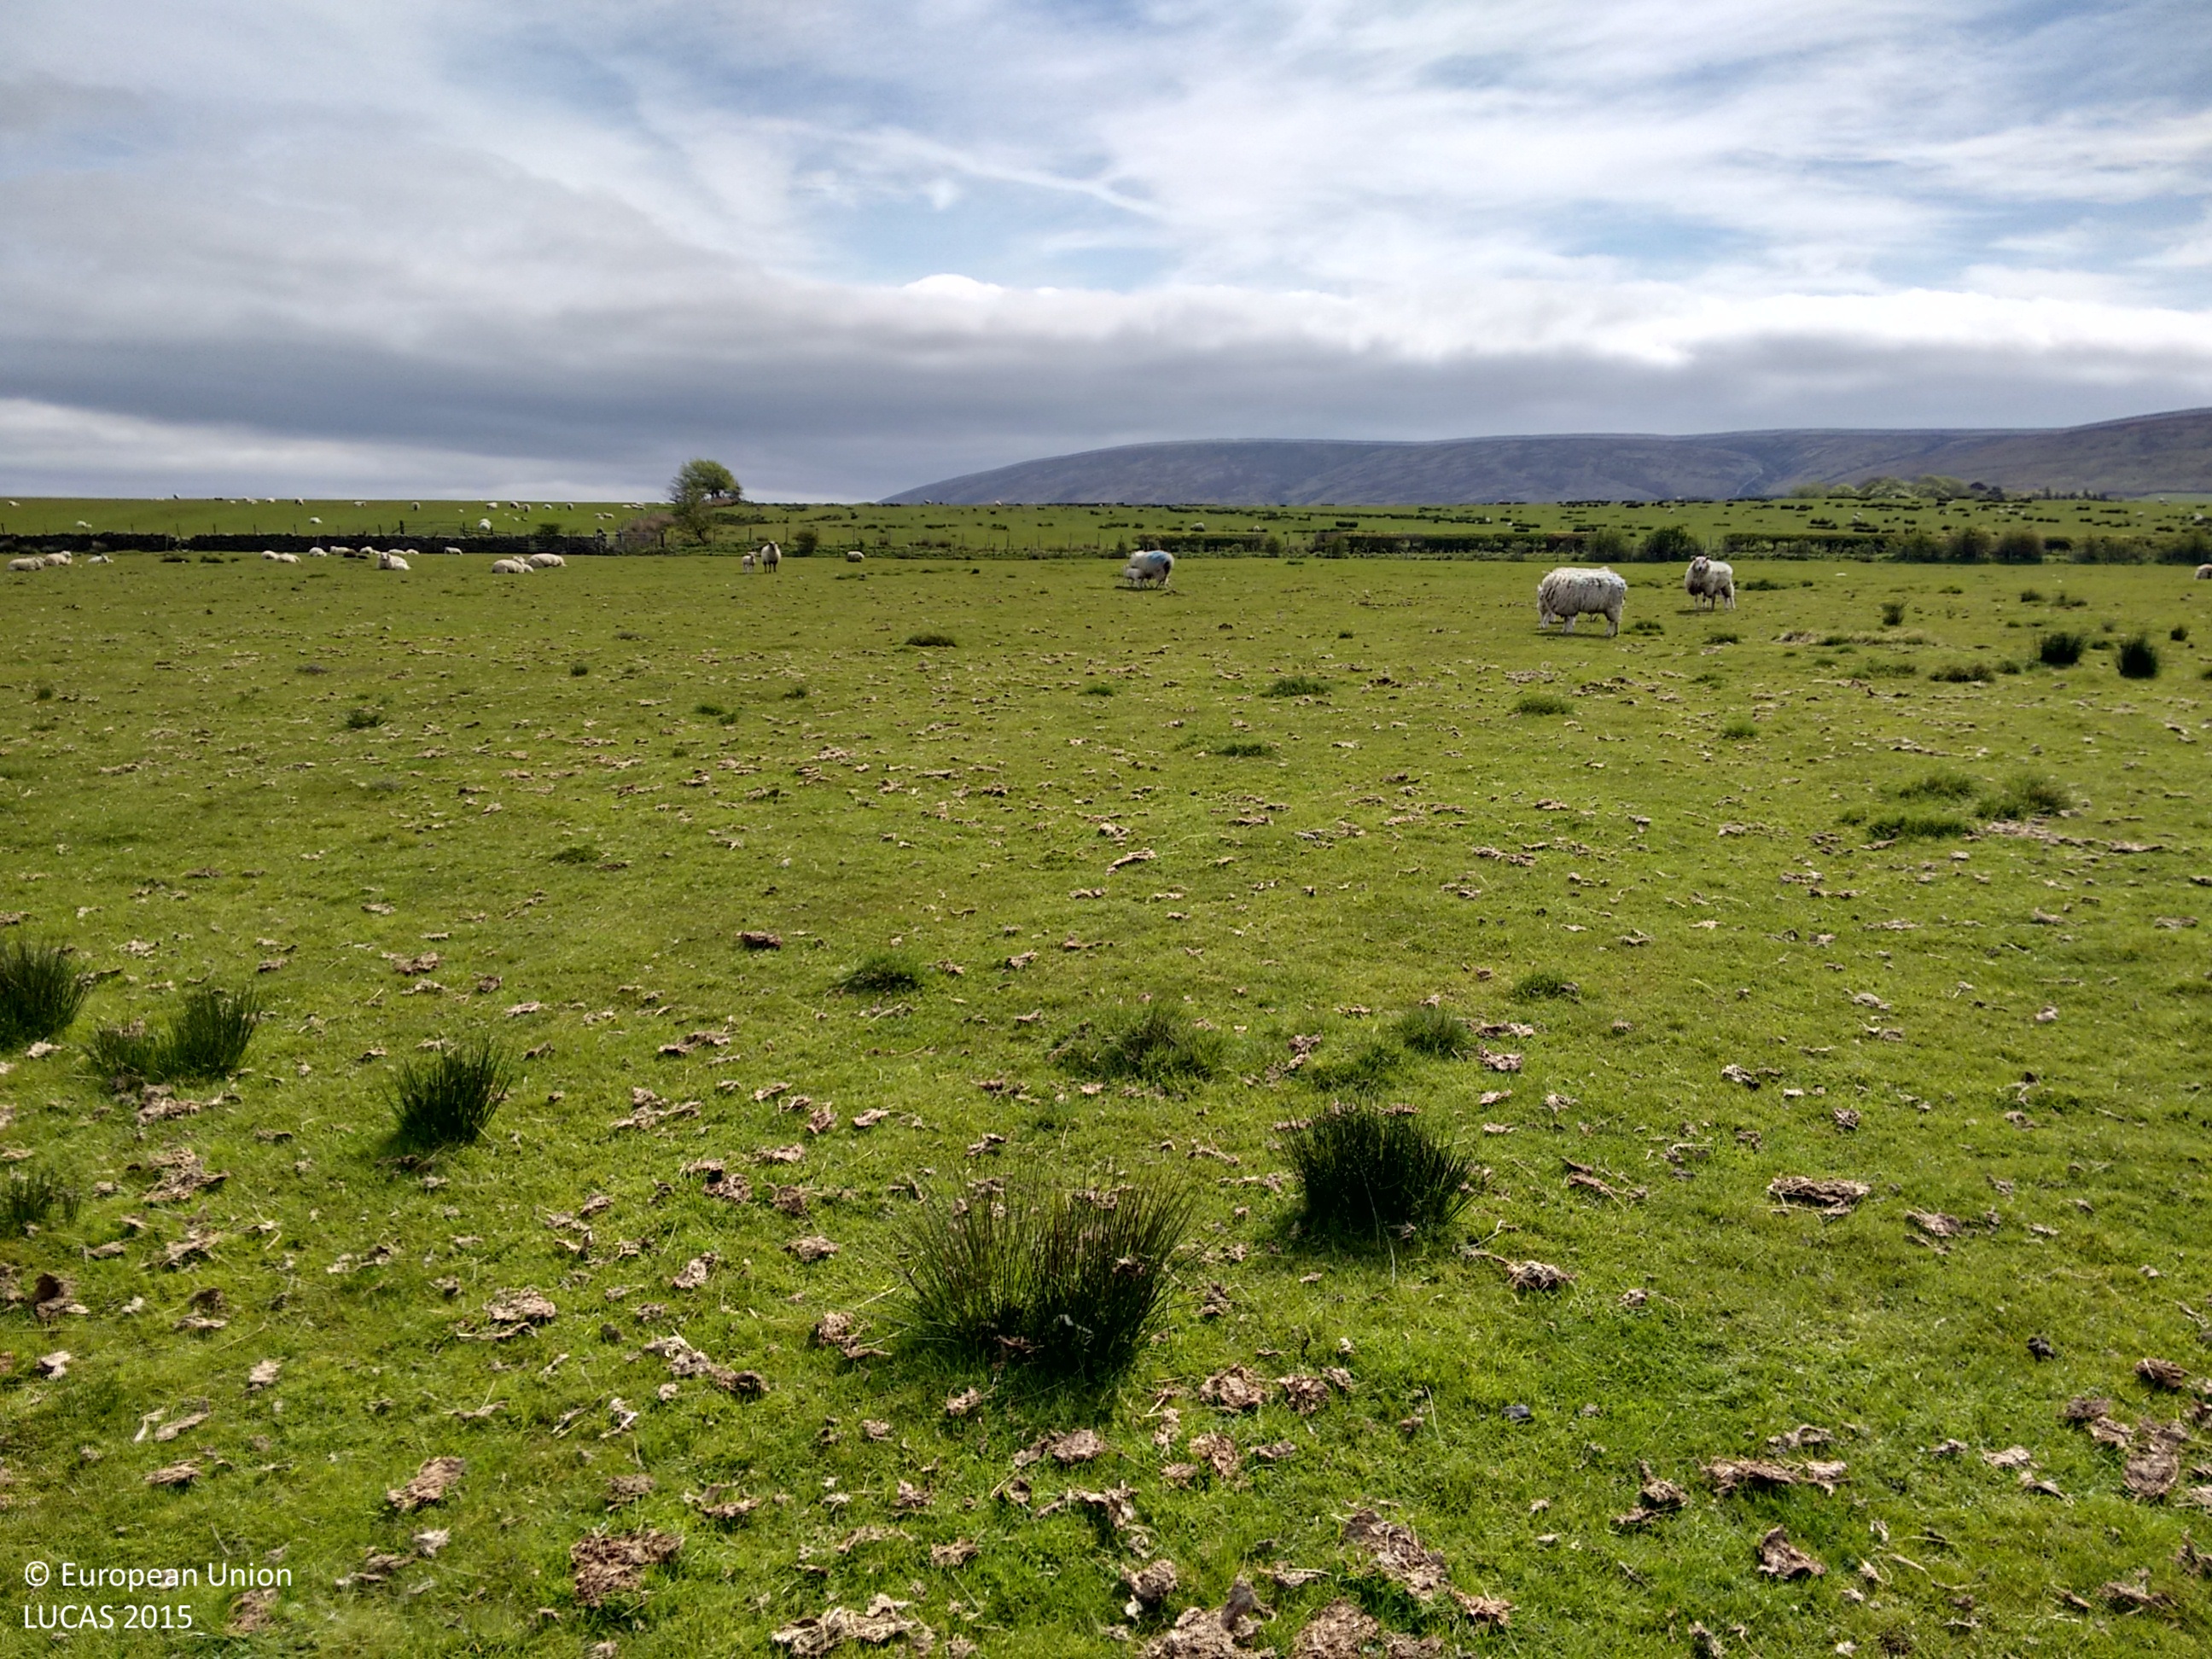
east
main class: Grassland
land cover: Grassland without tree/shrub cover
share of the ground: > 75 %
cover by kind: herbaceous plants 100 %
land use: Agriculture (excluding fallow land and kitchen gardens)
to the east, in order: Grassland without tree/shrub cover; Fences; Tracks; Managed hedges; Grassland without tree/shrub cover; Managed hedges
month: May
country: GB
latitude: 53.9677
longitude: -2.7054
